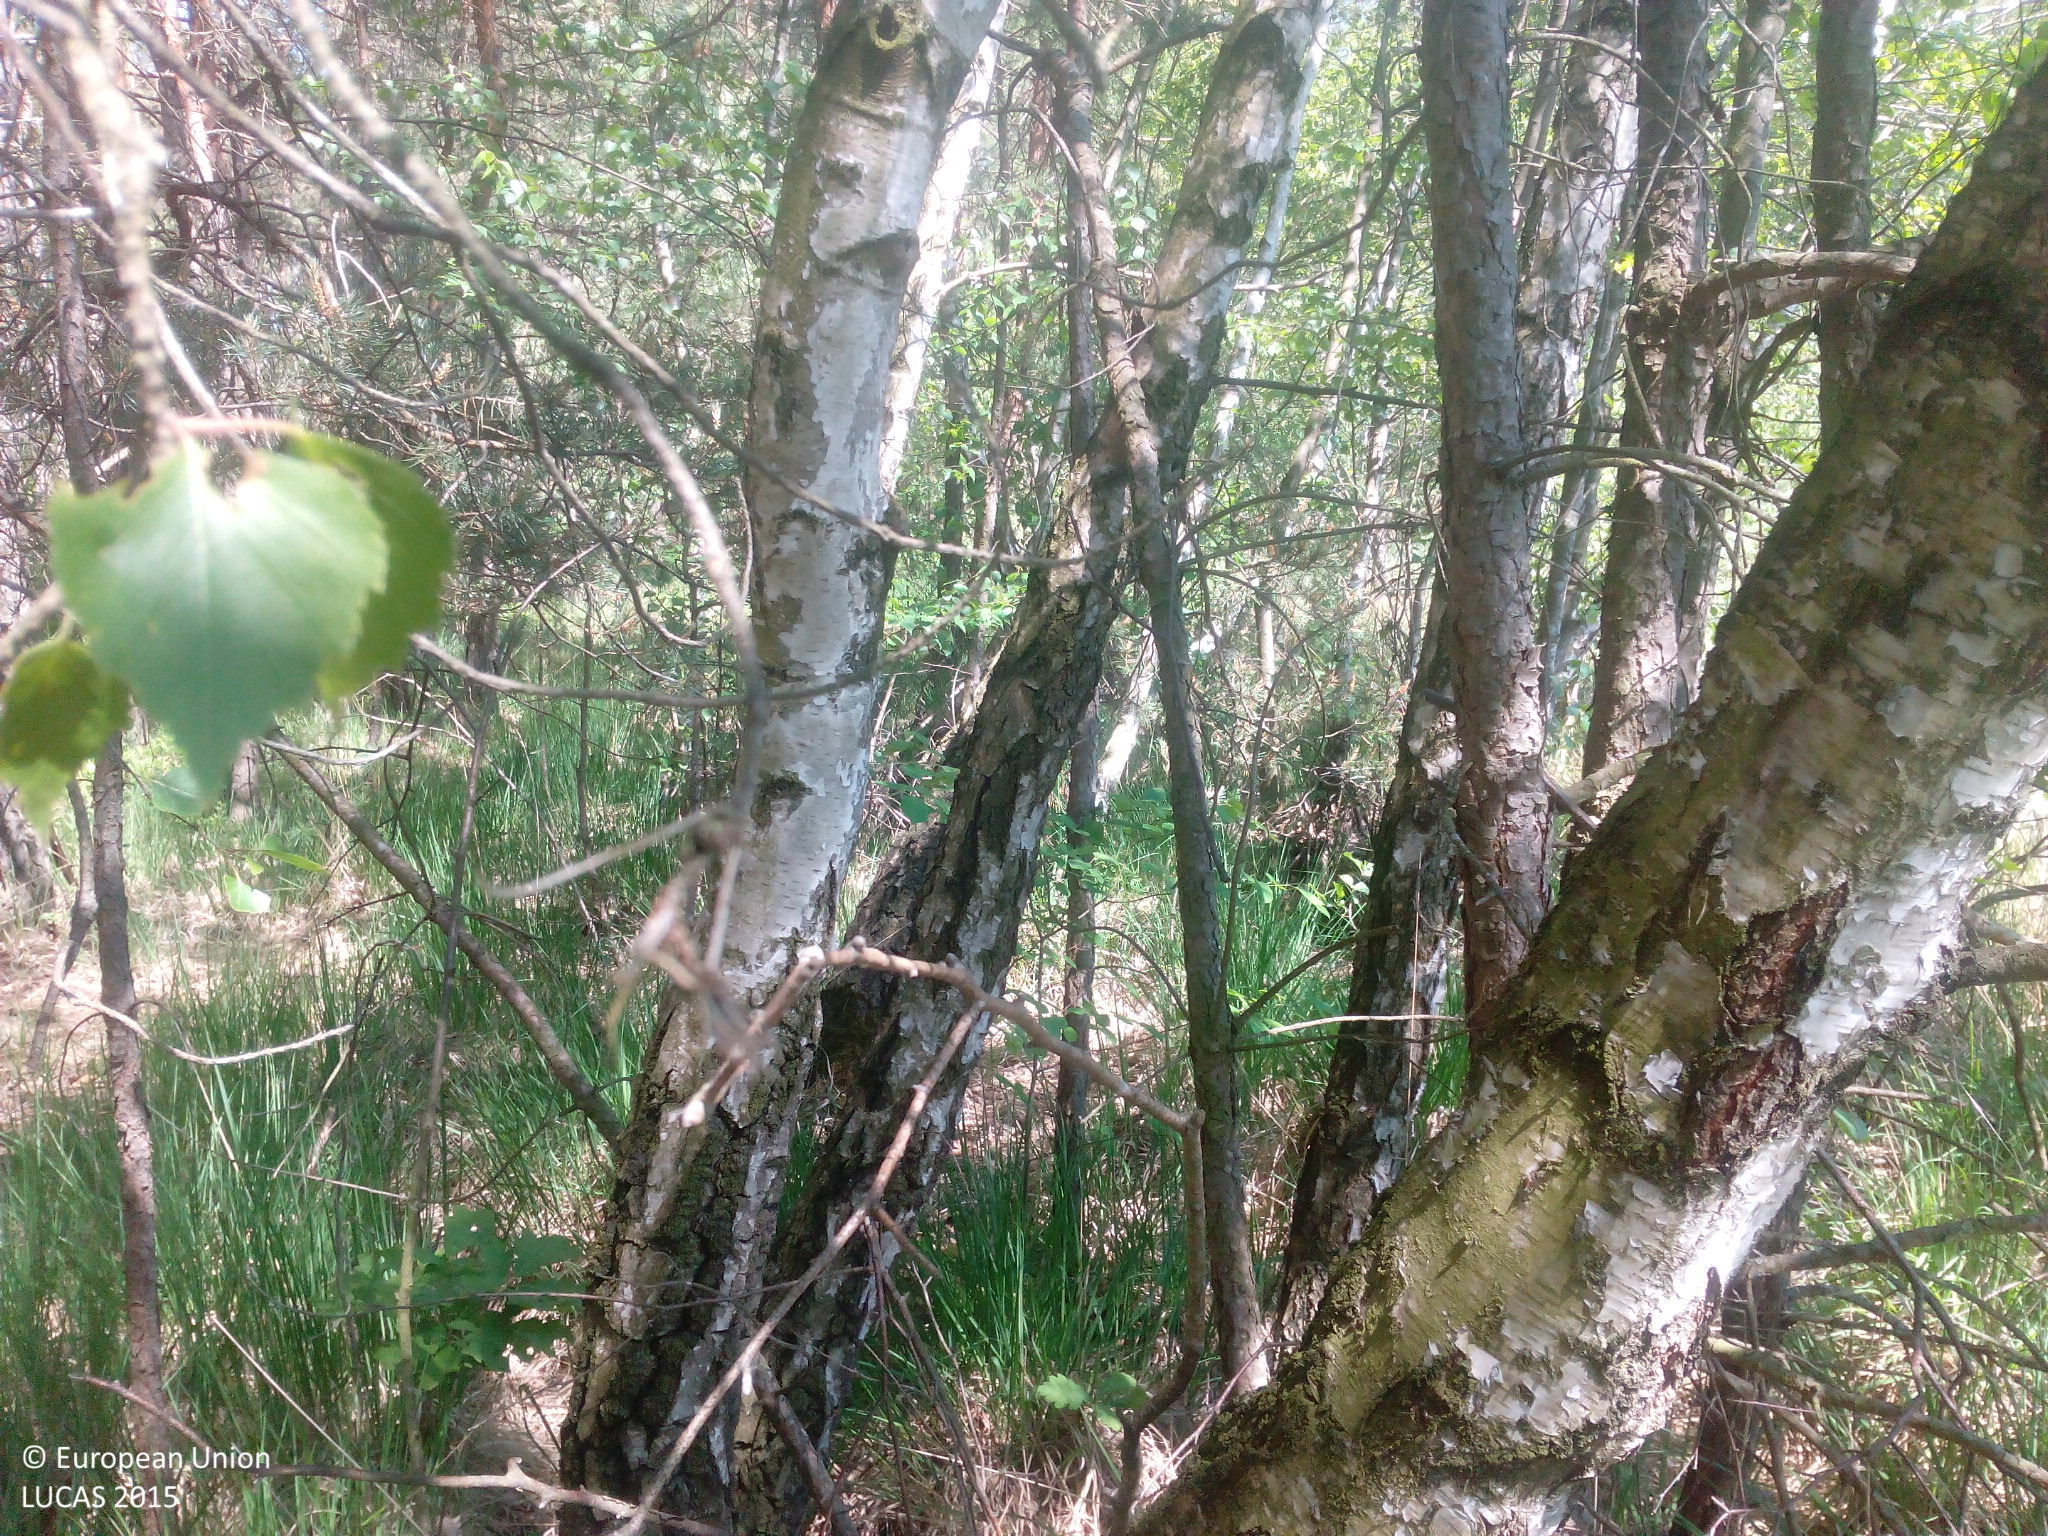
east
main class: Woodland
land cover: Pine dominated mixed woodland
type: hemiboreal forest and nemoral coniferous forest and mixed broadleaved-coniferous forest
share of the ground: 50 - 75 %
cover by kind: coniferous forest trees 50 %, broadleaved forest trees 20 %, herbaceous plants 20 %
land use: Amenities, museums, leisure
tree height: > 5 m
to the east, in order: Pine dominated mixed woodland; Tracks; Pine dominated coniferous woodland; Tracks; Pine dominated coniferous woodland; Spruce dominated coniferous woodland; Tracks; Spruce dominated coniferous woodland; Spruce dominated mixed woodland
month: June
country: DE
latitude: 49.2407
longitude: 12.4306
